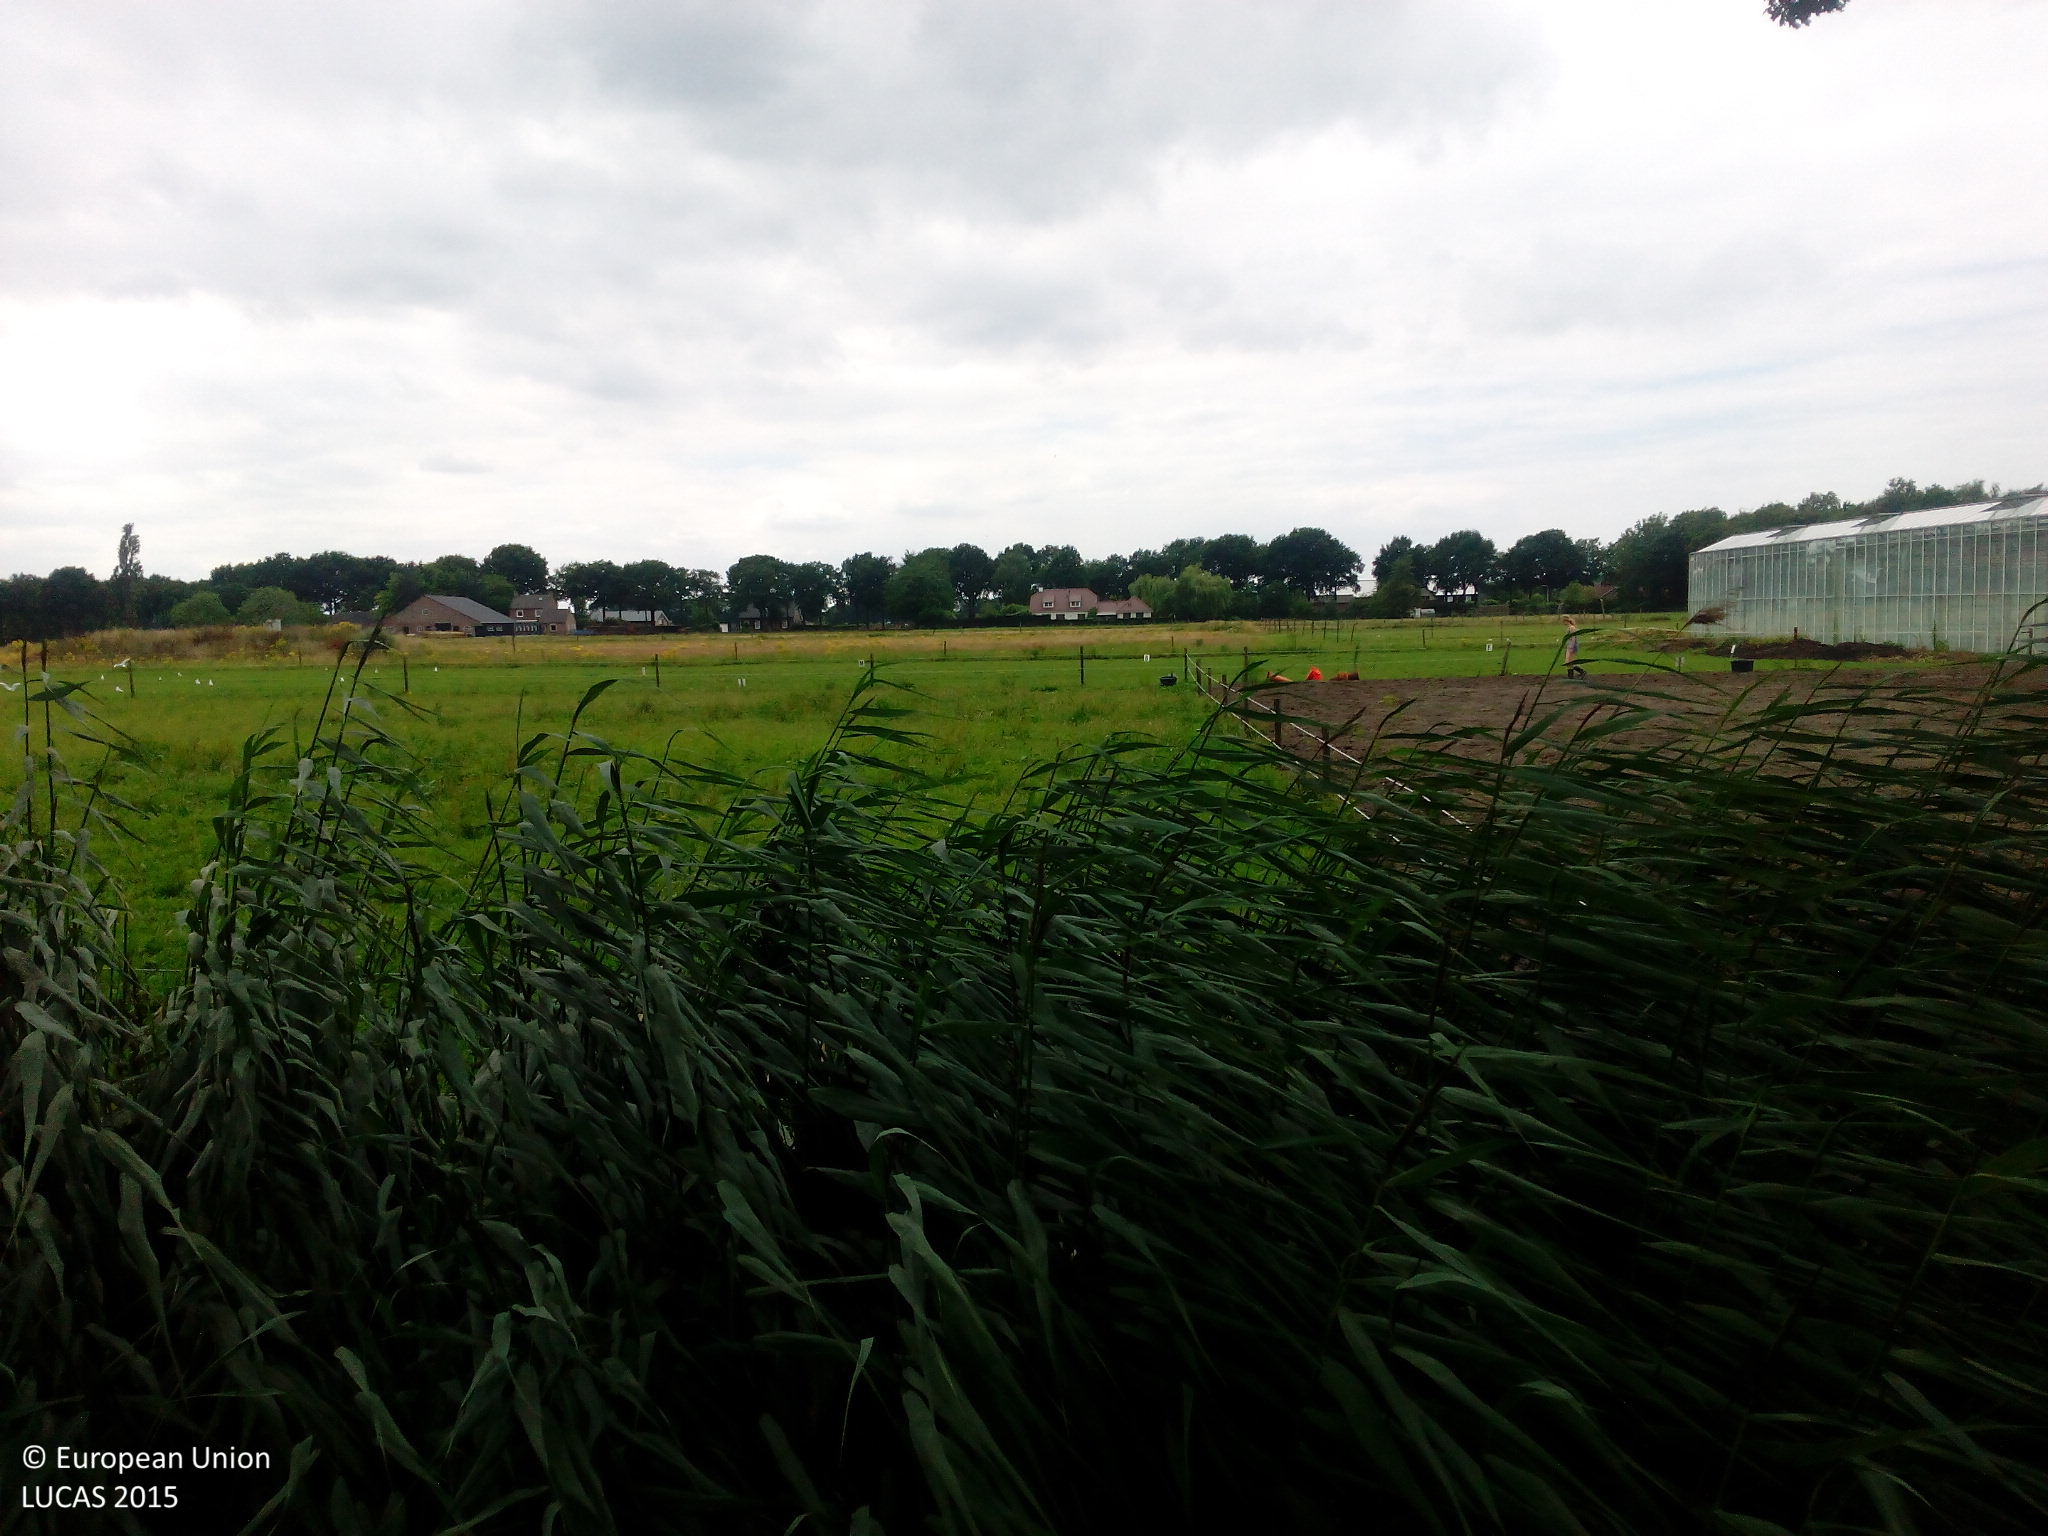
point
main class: Grassland
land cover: Grassland without tree/shrub cover
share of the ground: > 75 %
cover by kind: herbaceous plants 100 %
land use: Amenities, museums, leisure
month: July
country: NL
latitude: 51.5925
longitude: 4.6988
